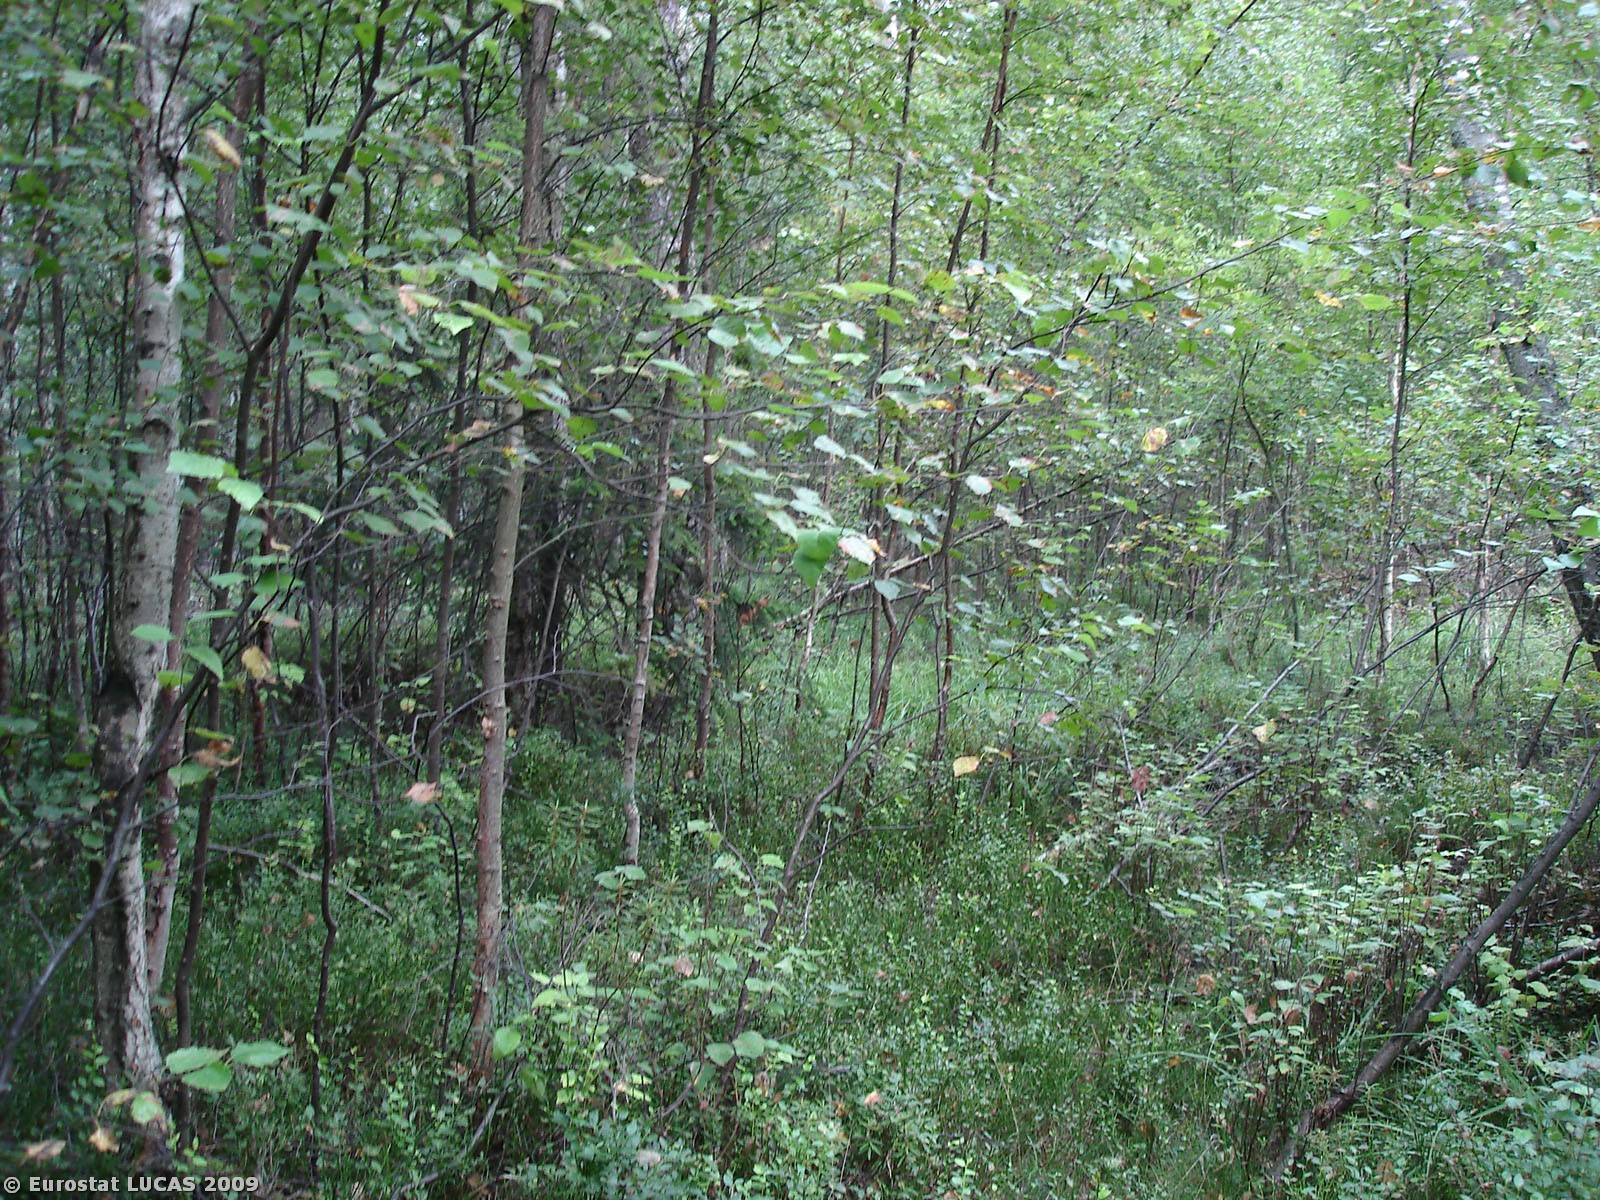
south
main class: Woodland
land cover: Mixed woodland
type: hemiboreal forest and nemoral coniferous forest and mixed broadleaved-coniferous forest
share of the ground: > 75 %
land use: Forestry
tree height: > 5 m
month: August
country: PL
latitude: 50.7640
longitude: 18.8262
